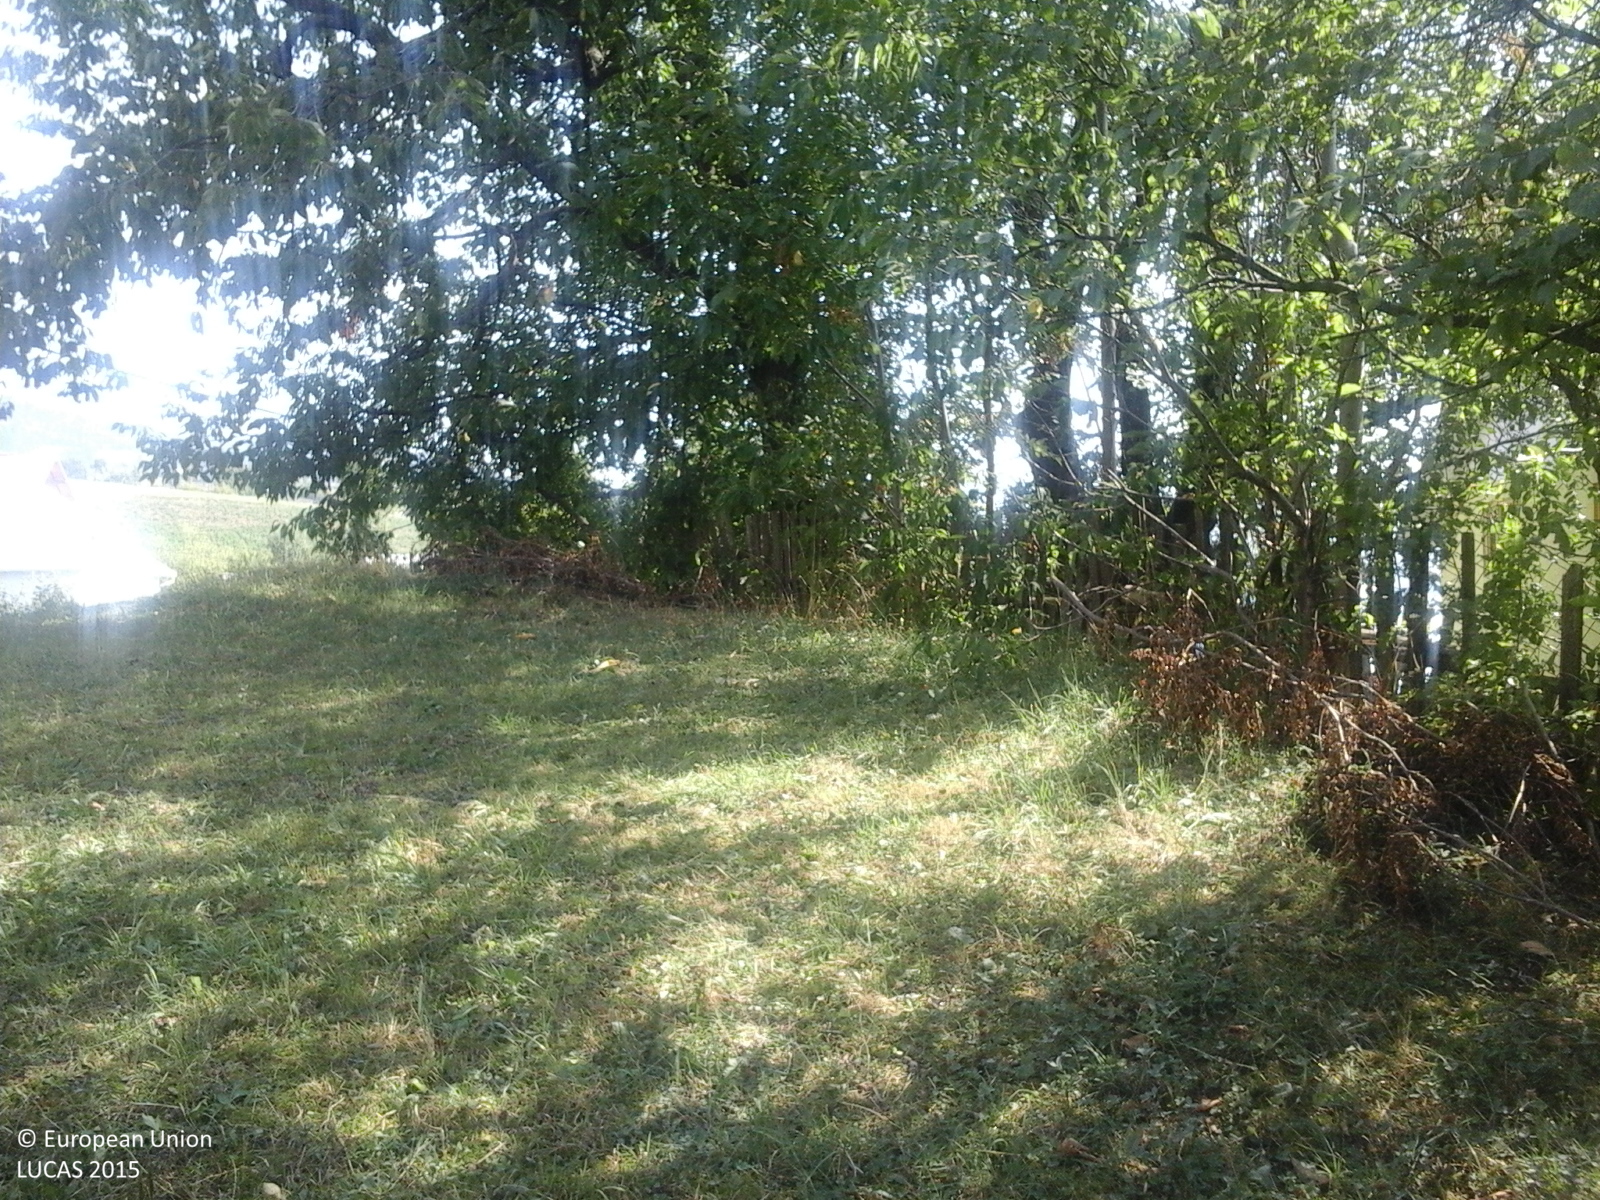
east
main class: Grassland
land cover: Grassland with sparse tree/shrub cover
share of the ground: > 75 %
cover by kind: herbaceous plants 85 %, shrubs 10 %, broadleaved forest trees 5 %
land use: Agriculture (excluding fallow land and kitchen gardens)
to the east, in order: Grassland with sparse tree/shrub cover; Artificial constructions in urban areas; Apple fruit; Artificial constructions in urban areas
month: September
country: RO
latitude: 47.6620
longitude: 24.6250
